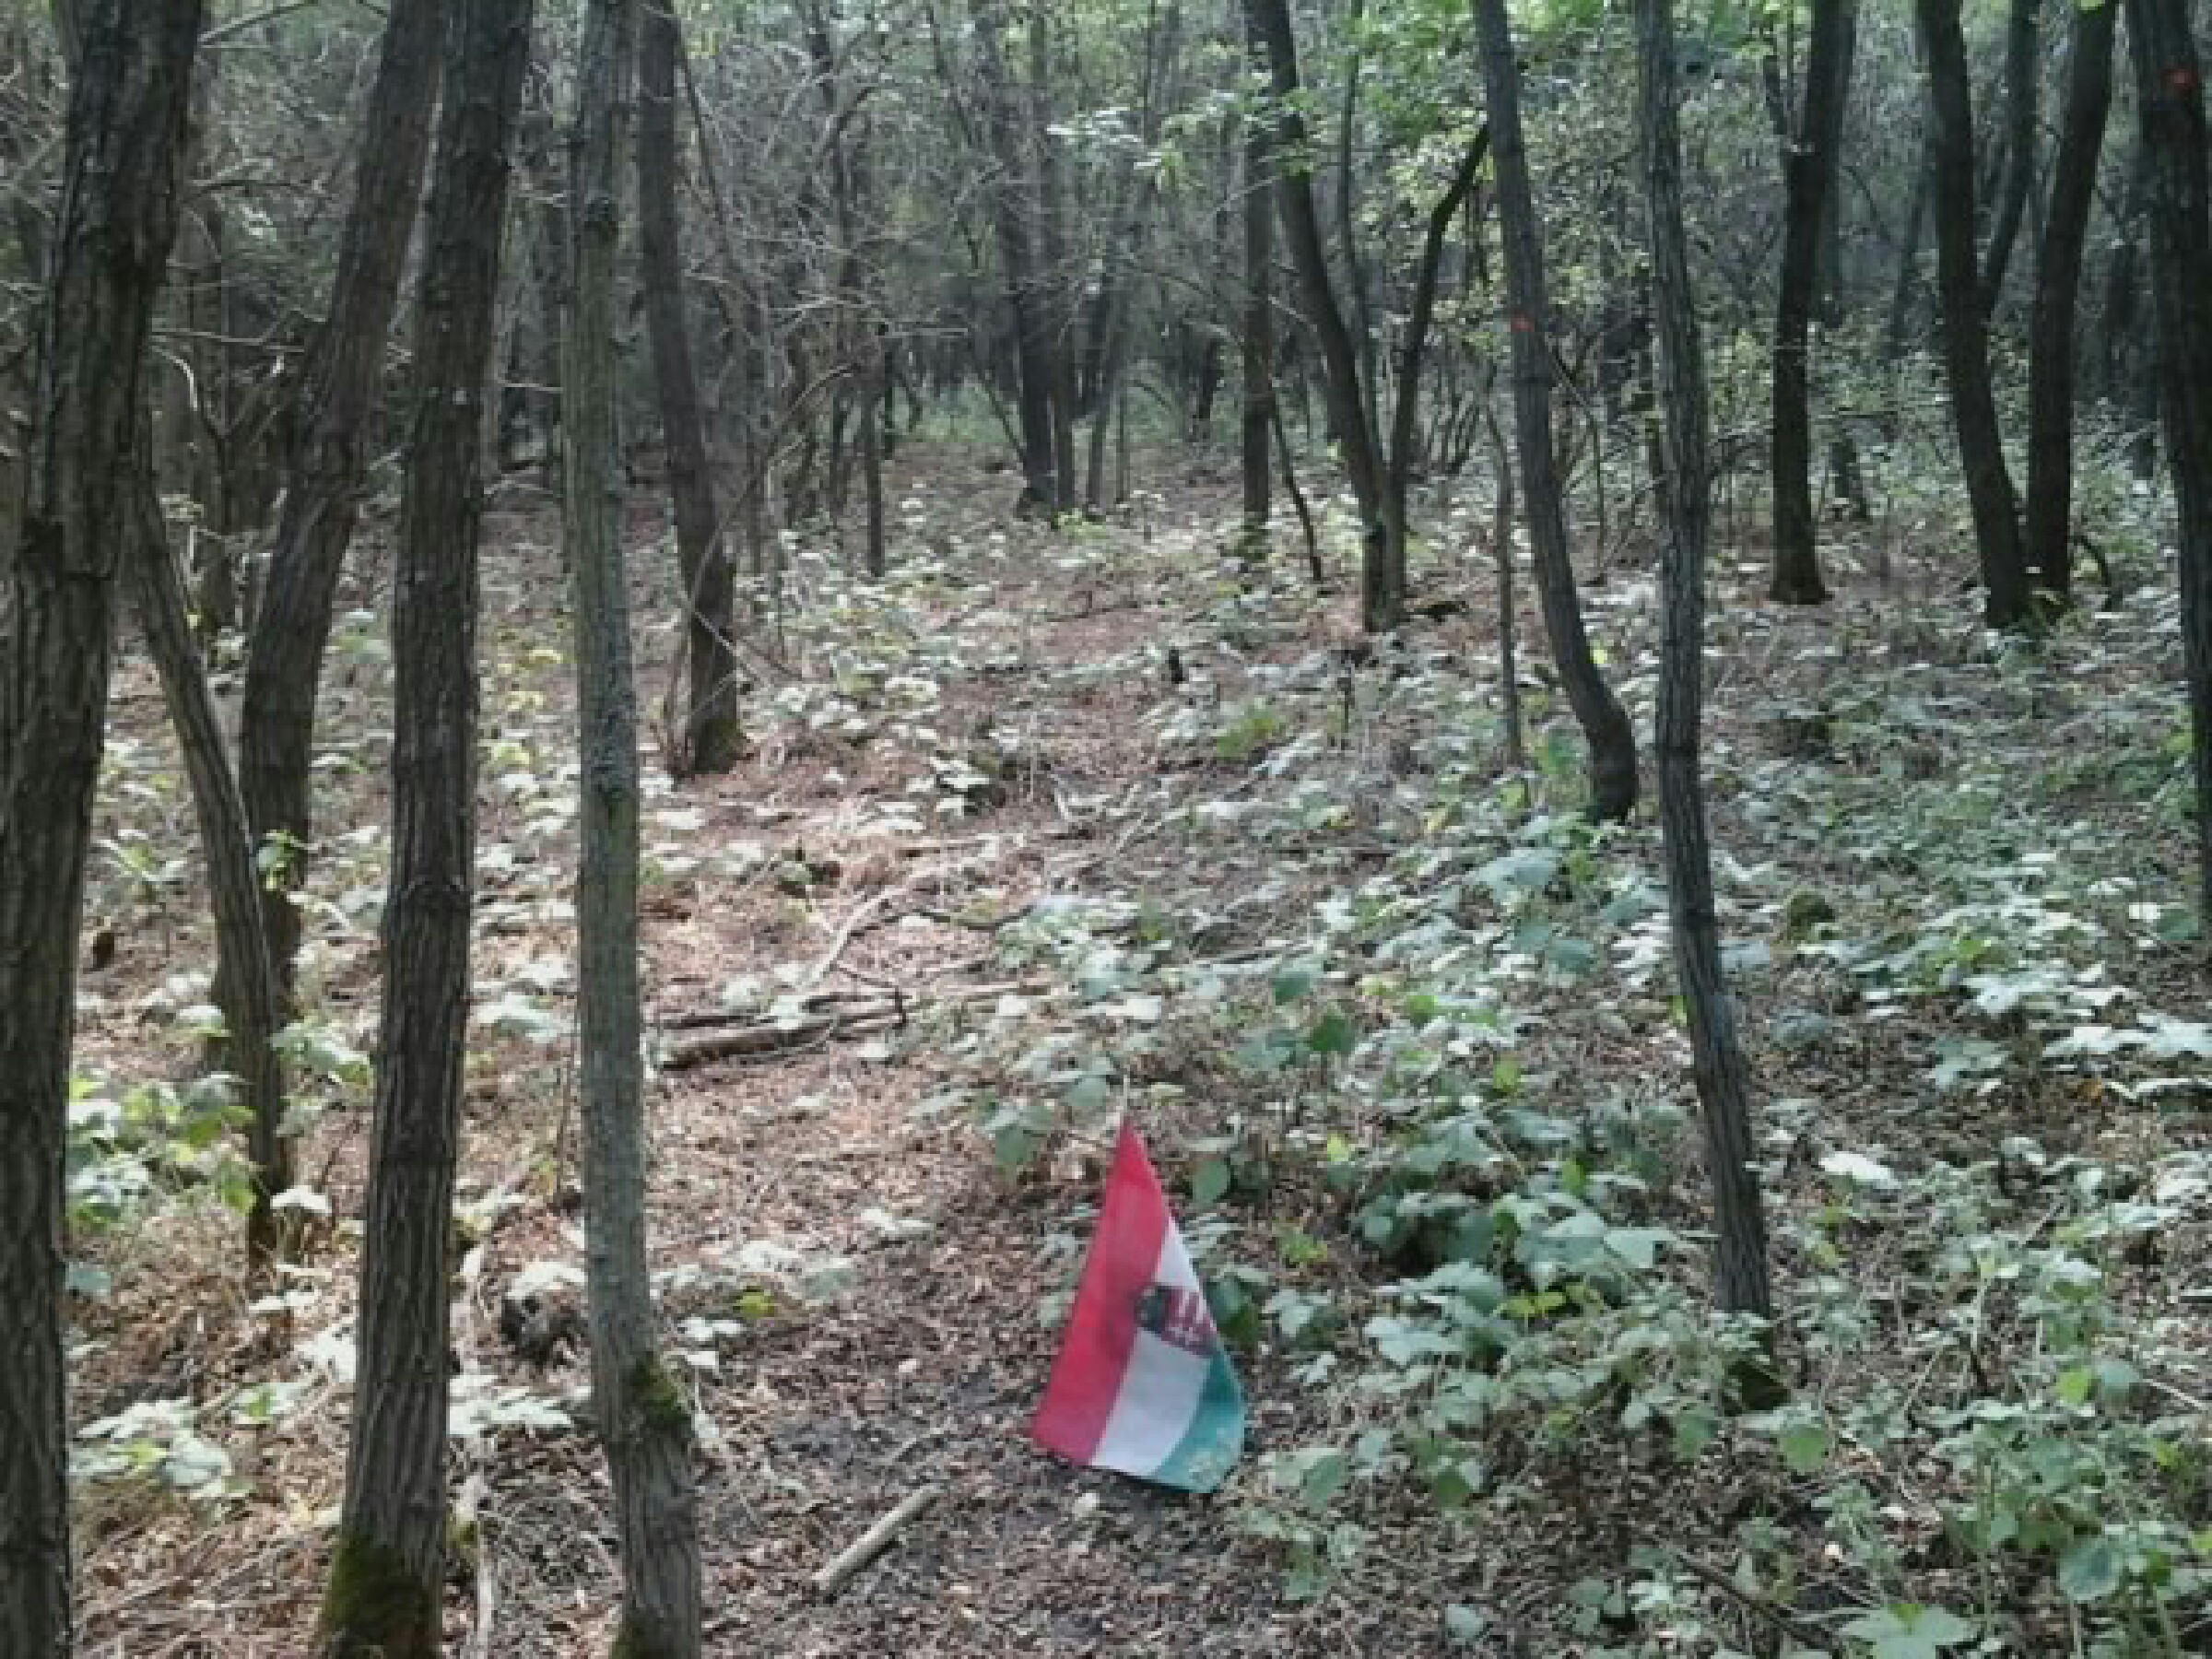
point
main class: Woodland
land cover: Broadleaved woodland
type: exotic forest
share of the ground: > 75 %
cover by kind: broadleaved forest trees 100 %
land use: Forestry
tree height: > 5 m
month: August
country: HU
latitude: 47.8535
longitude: 19.4446
